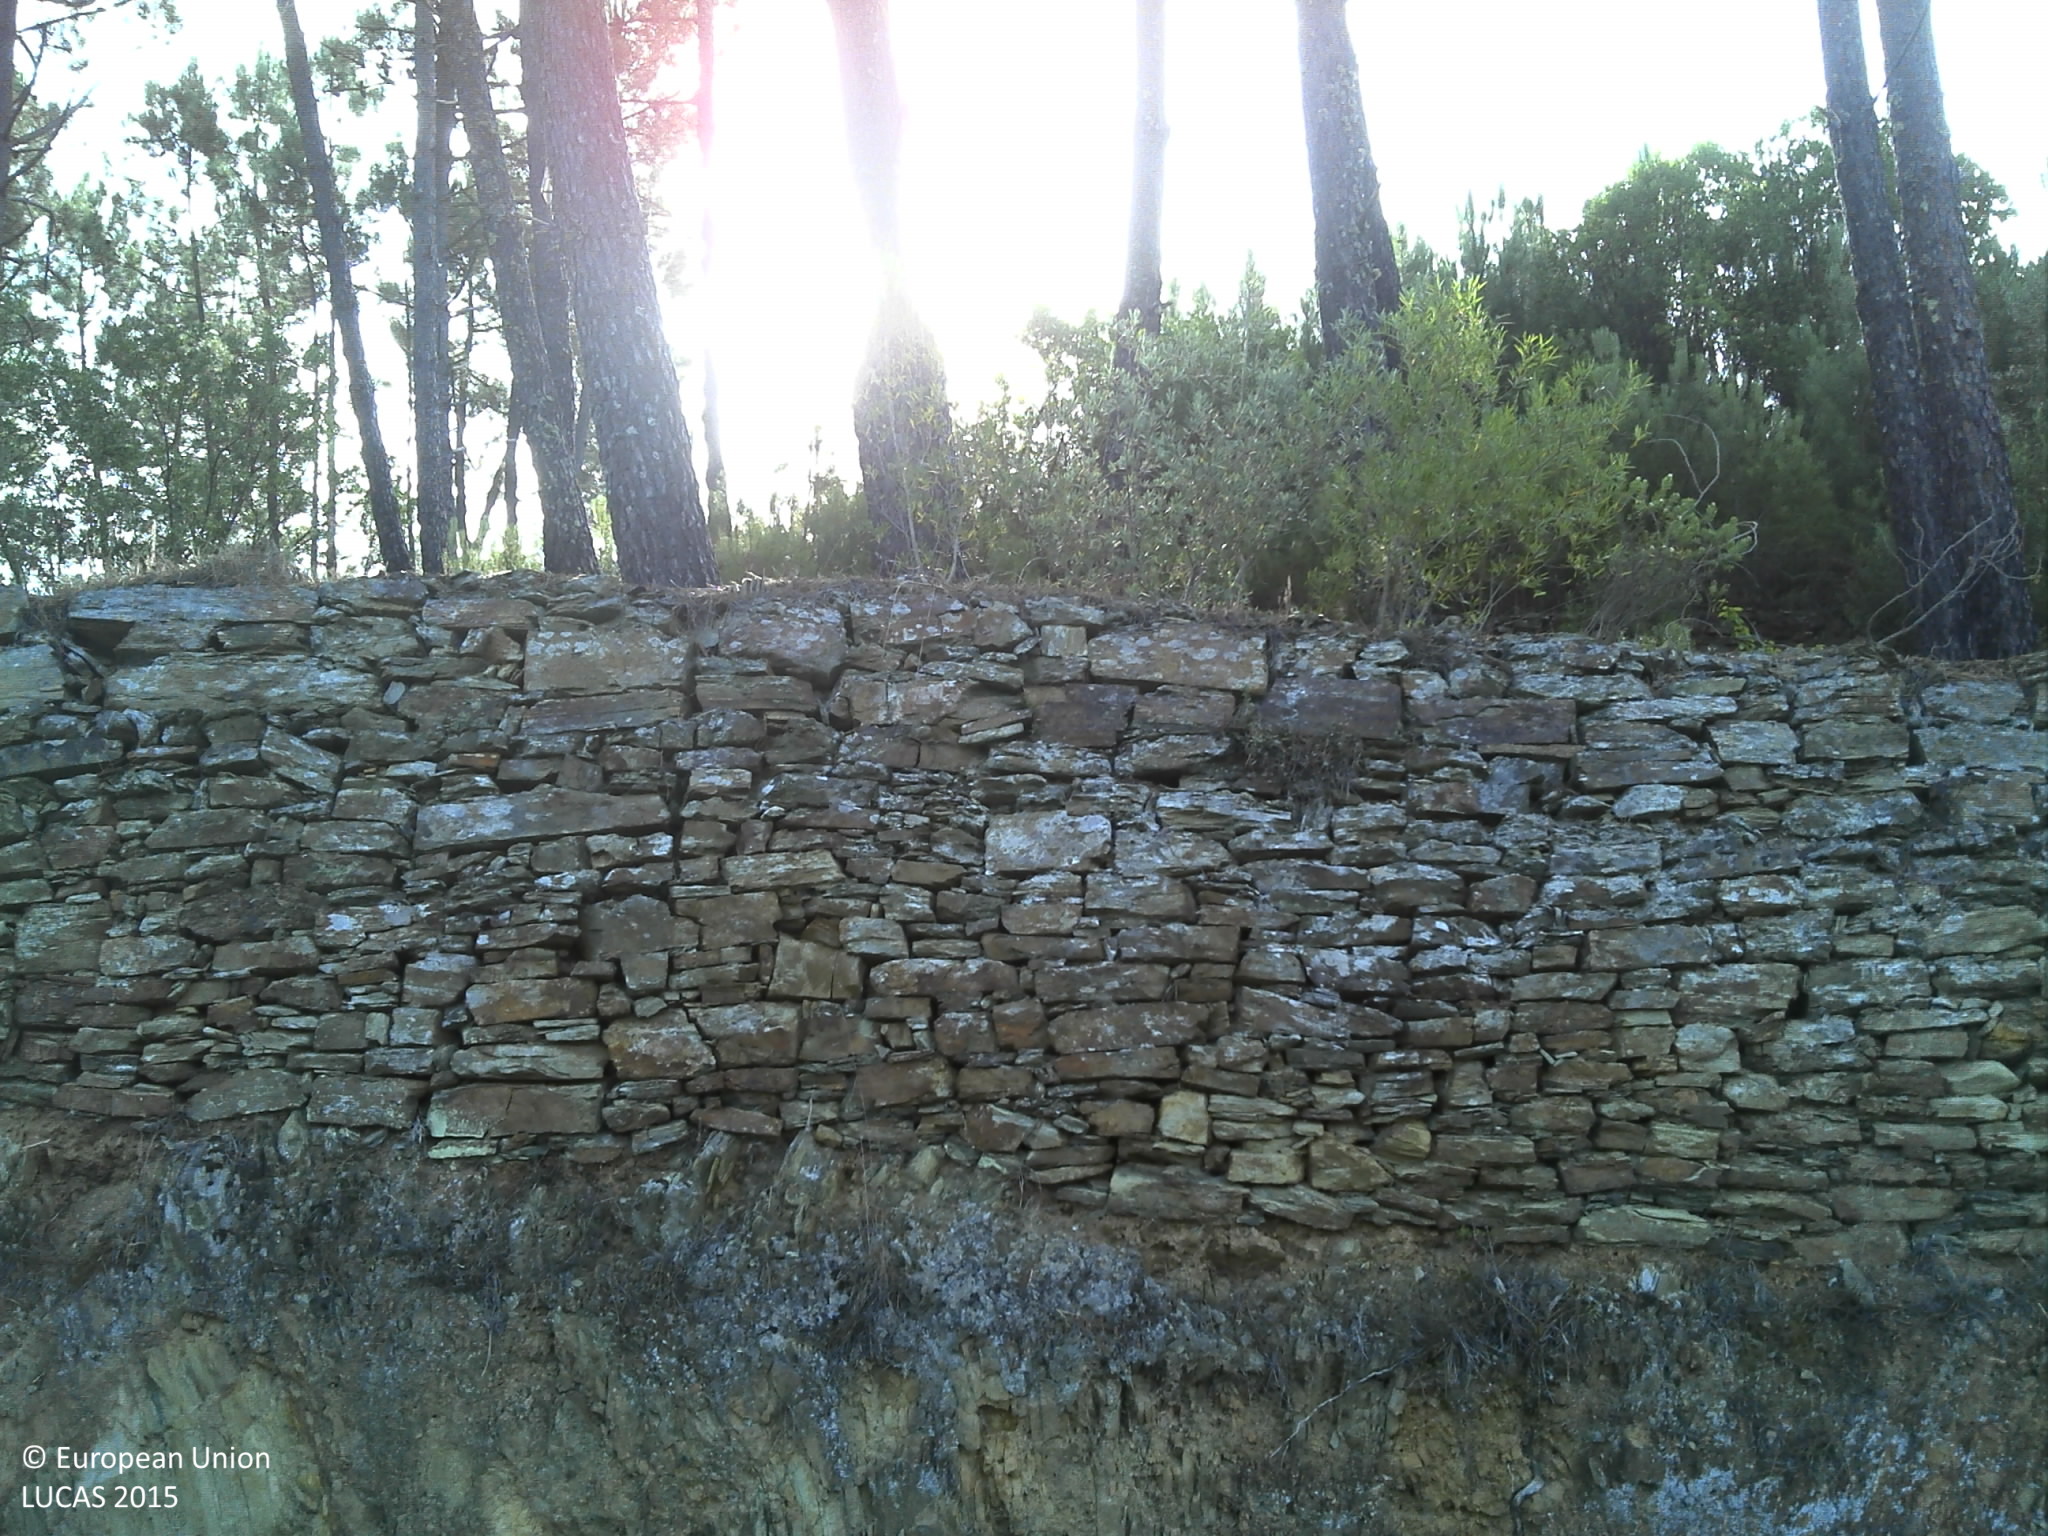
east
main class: Woodland
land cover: Broadleaved woodland
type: exotic forest
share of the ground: < 10 %
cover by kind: shrubs 90 %, broadleaved forest trees 10 %
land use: Forestry
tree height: < 5 m
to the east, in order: Broadleaved woodland; Paved roads, cycling and walking lanes; Dry stone walls; Pine dominated coniferous woodland; Dry stone walls; Pine dominated coniferous woodland; Dry stone walls; Olive groves; Dry stone walls; Vineyards; Spontaneously vegetated surfaces; Dry stone walls; Shrubland with sparse tree cover; Dry stone walls; Shrubland without tree cover; Dry stone walls; Shrubland with sparse tree cover; Dry stone walls; Shrubland with sparse tree cover; Tracks; Shrubland with sparse tree cover; Pine dominated coniferous woodland; Tracks; Pine dominated coniferous woodland
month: July
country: PT
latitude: 39.8253
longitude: -7.9994
